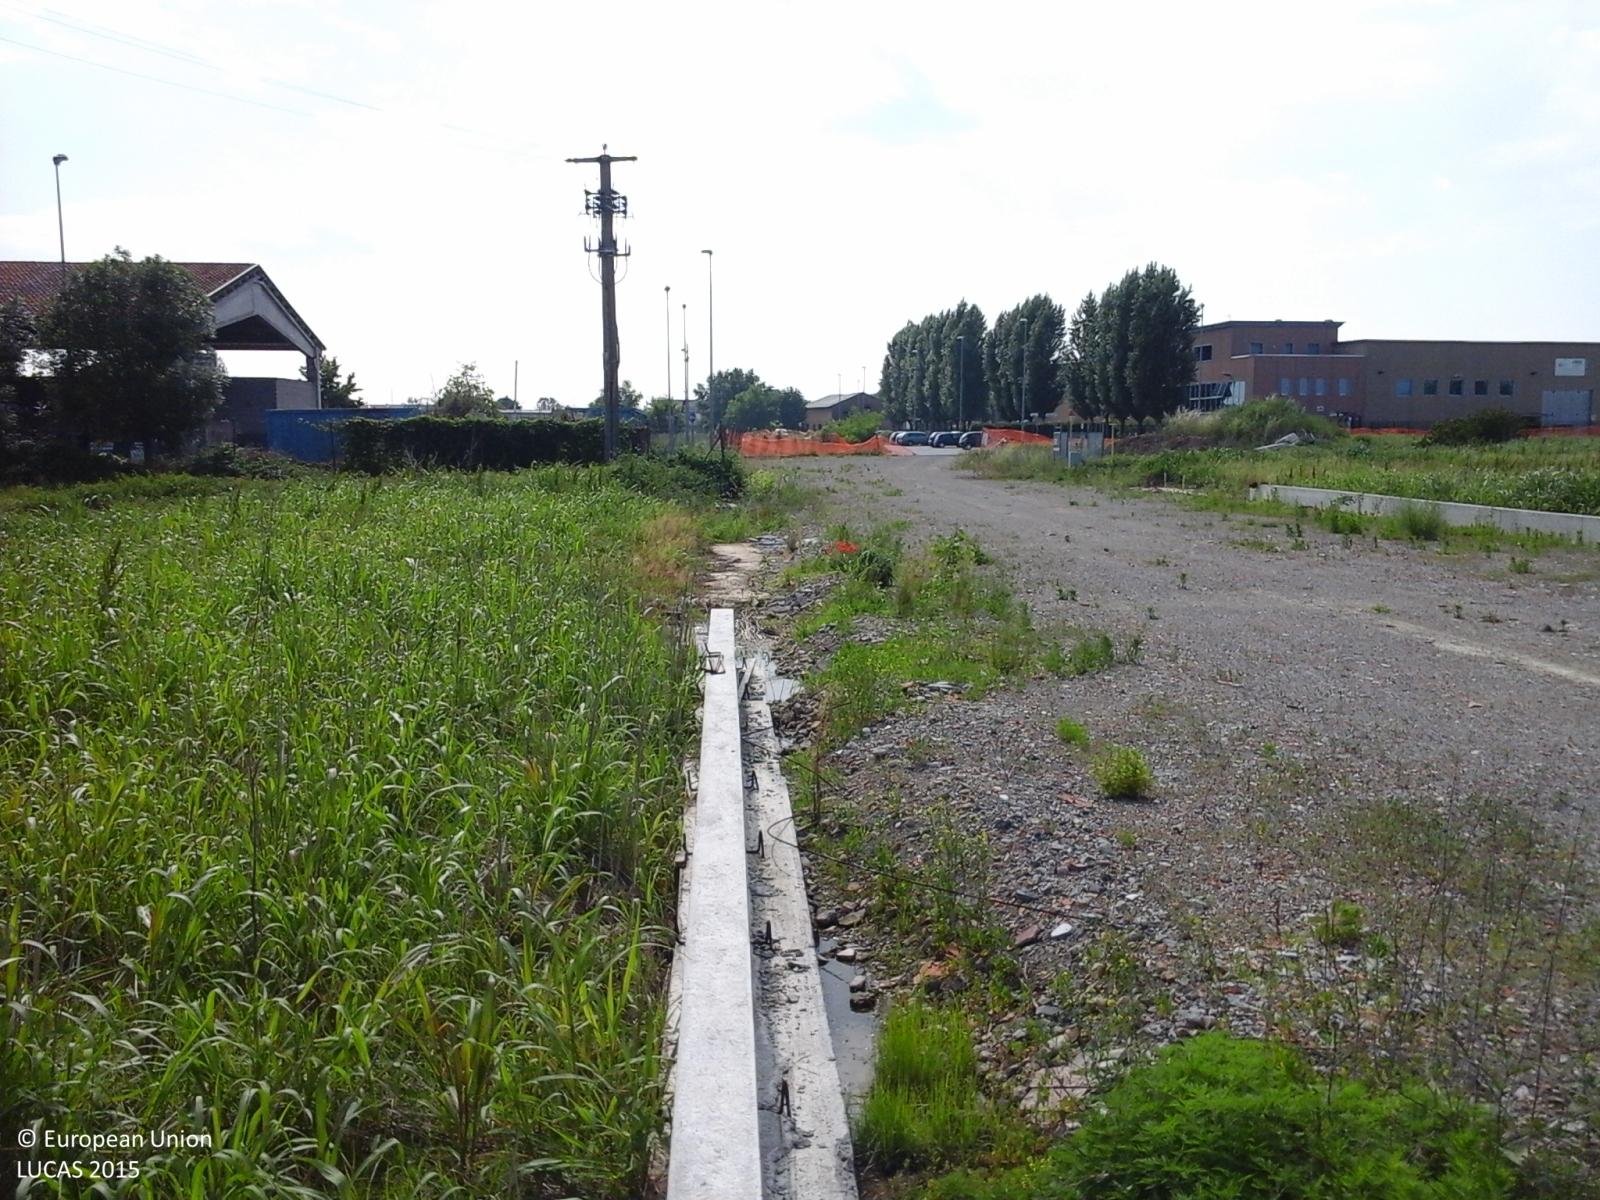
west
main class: Grassland
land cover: Spontaneously vegetated surfaces
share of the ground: > 75 %
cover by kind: herbaceous plants 100 %
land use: Fallow land
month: May
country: IT
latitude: 45.4858
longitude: 9.6551
